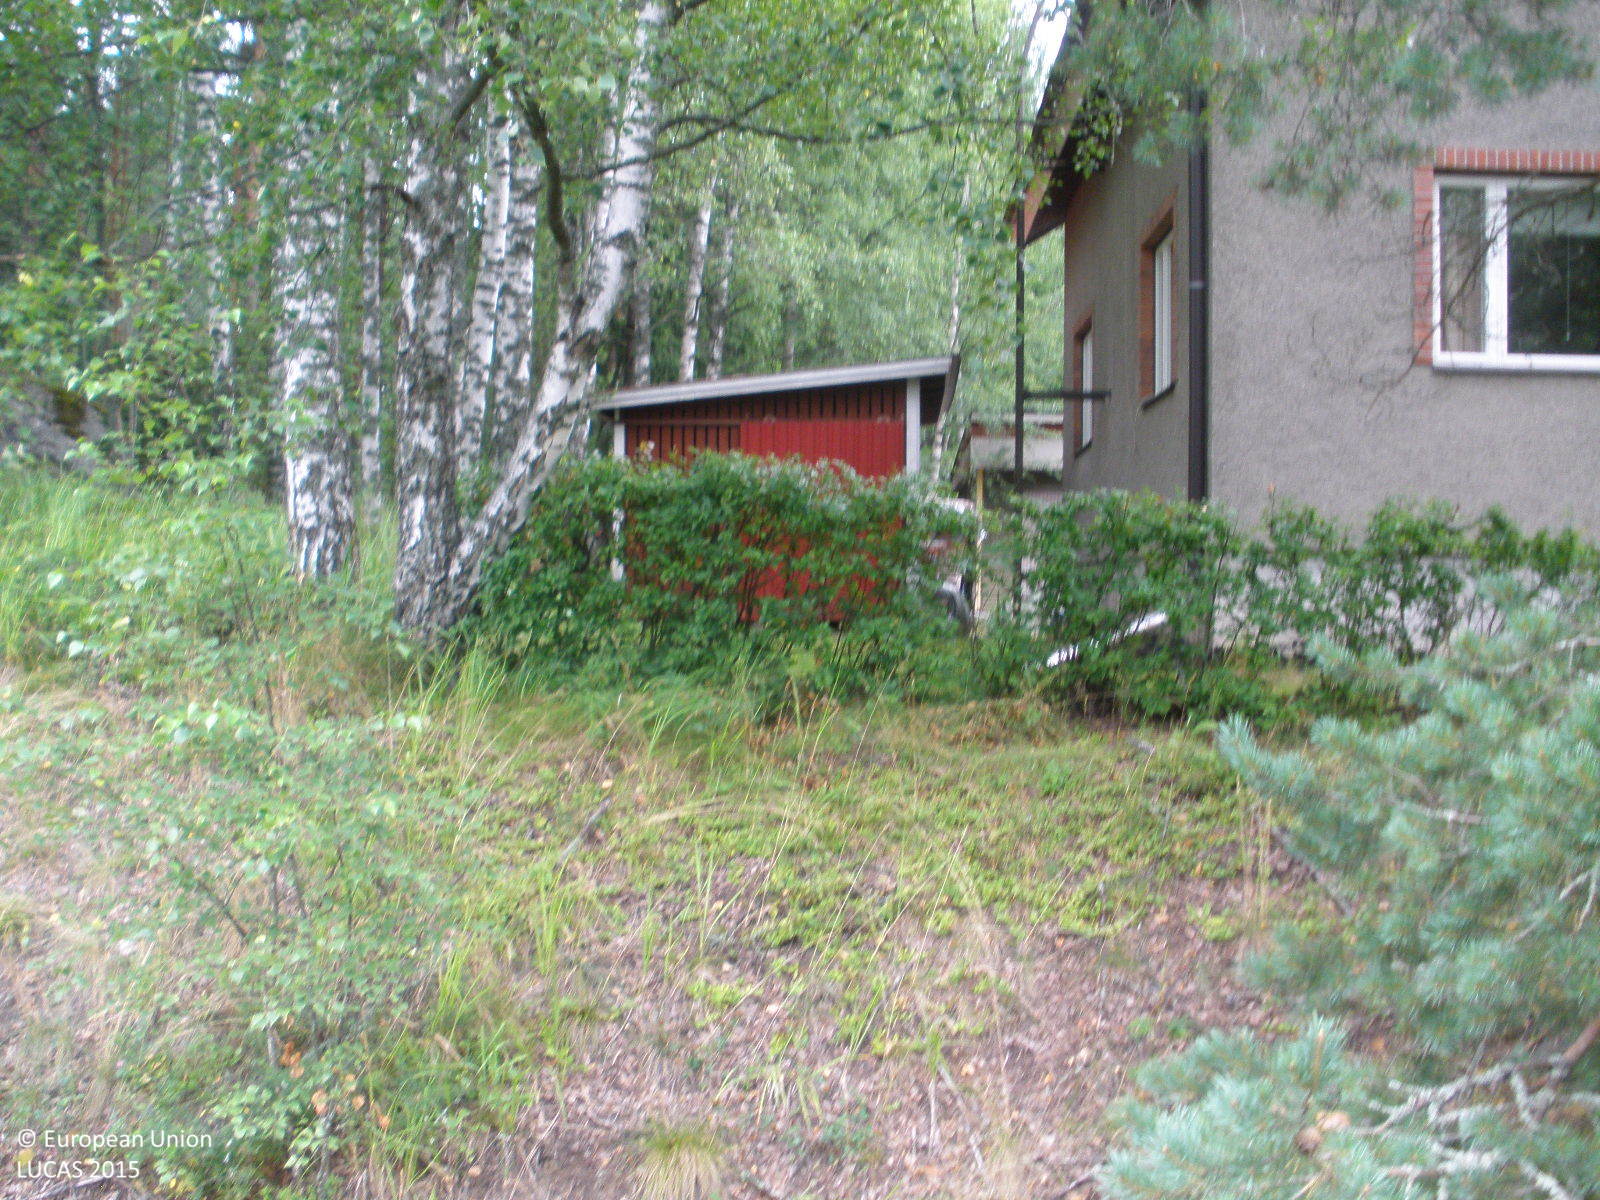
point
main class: Grassland
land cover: Grassland without tree/shrub cover
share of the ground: > 75 %
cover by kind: herbaceous plants 100 %
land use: Residential
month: August
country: FI
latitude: 60.9612
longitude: 24.5649
